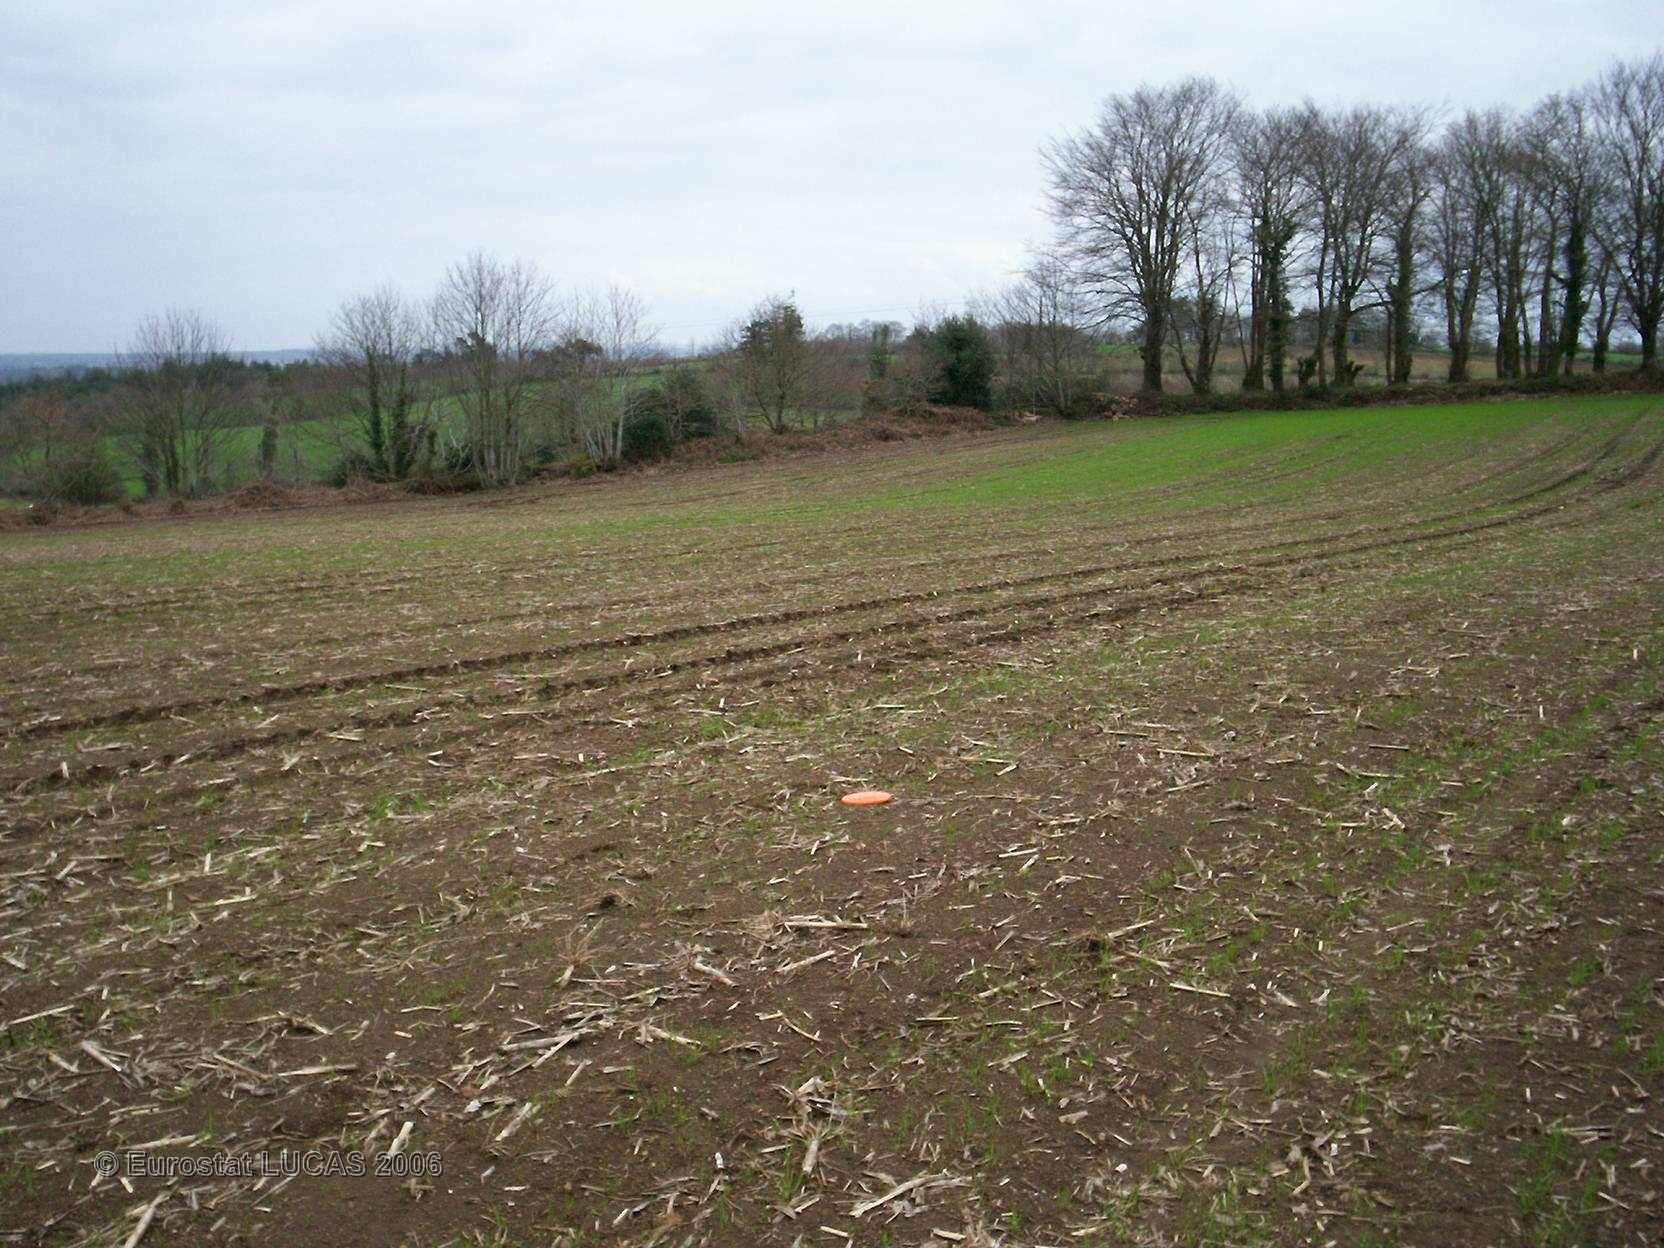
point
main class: Grassland
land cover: Grassland without tree/shrub cover
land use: Agriculture (excluding fallow land and kitchen gardens)
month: April
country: FR
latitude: 47.9674
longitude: -3.5383
